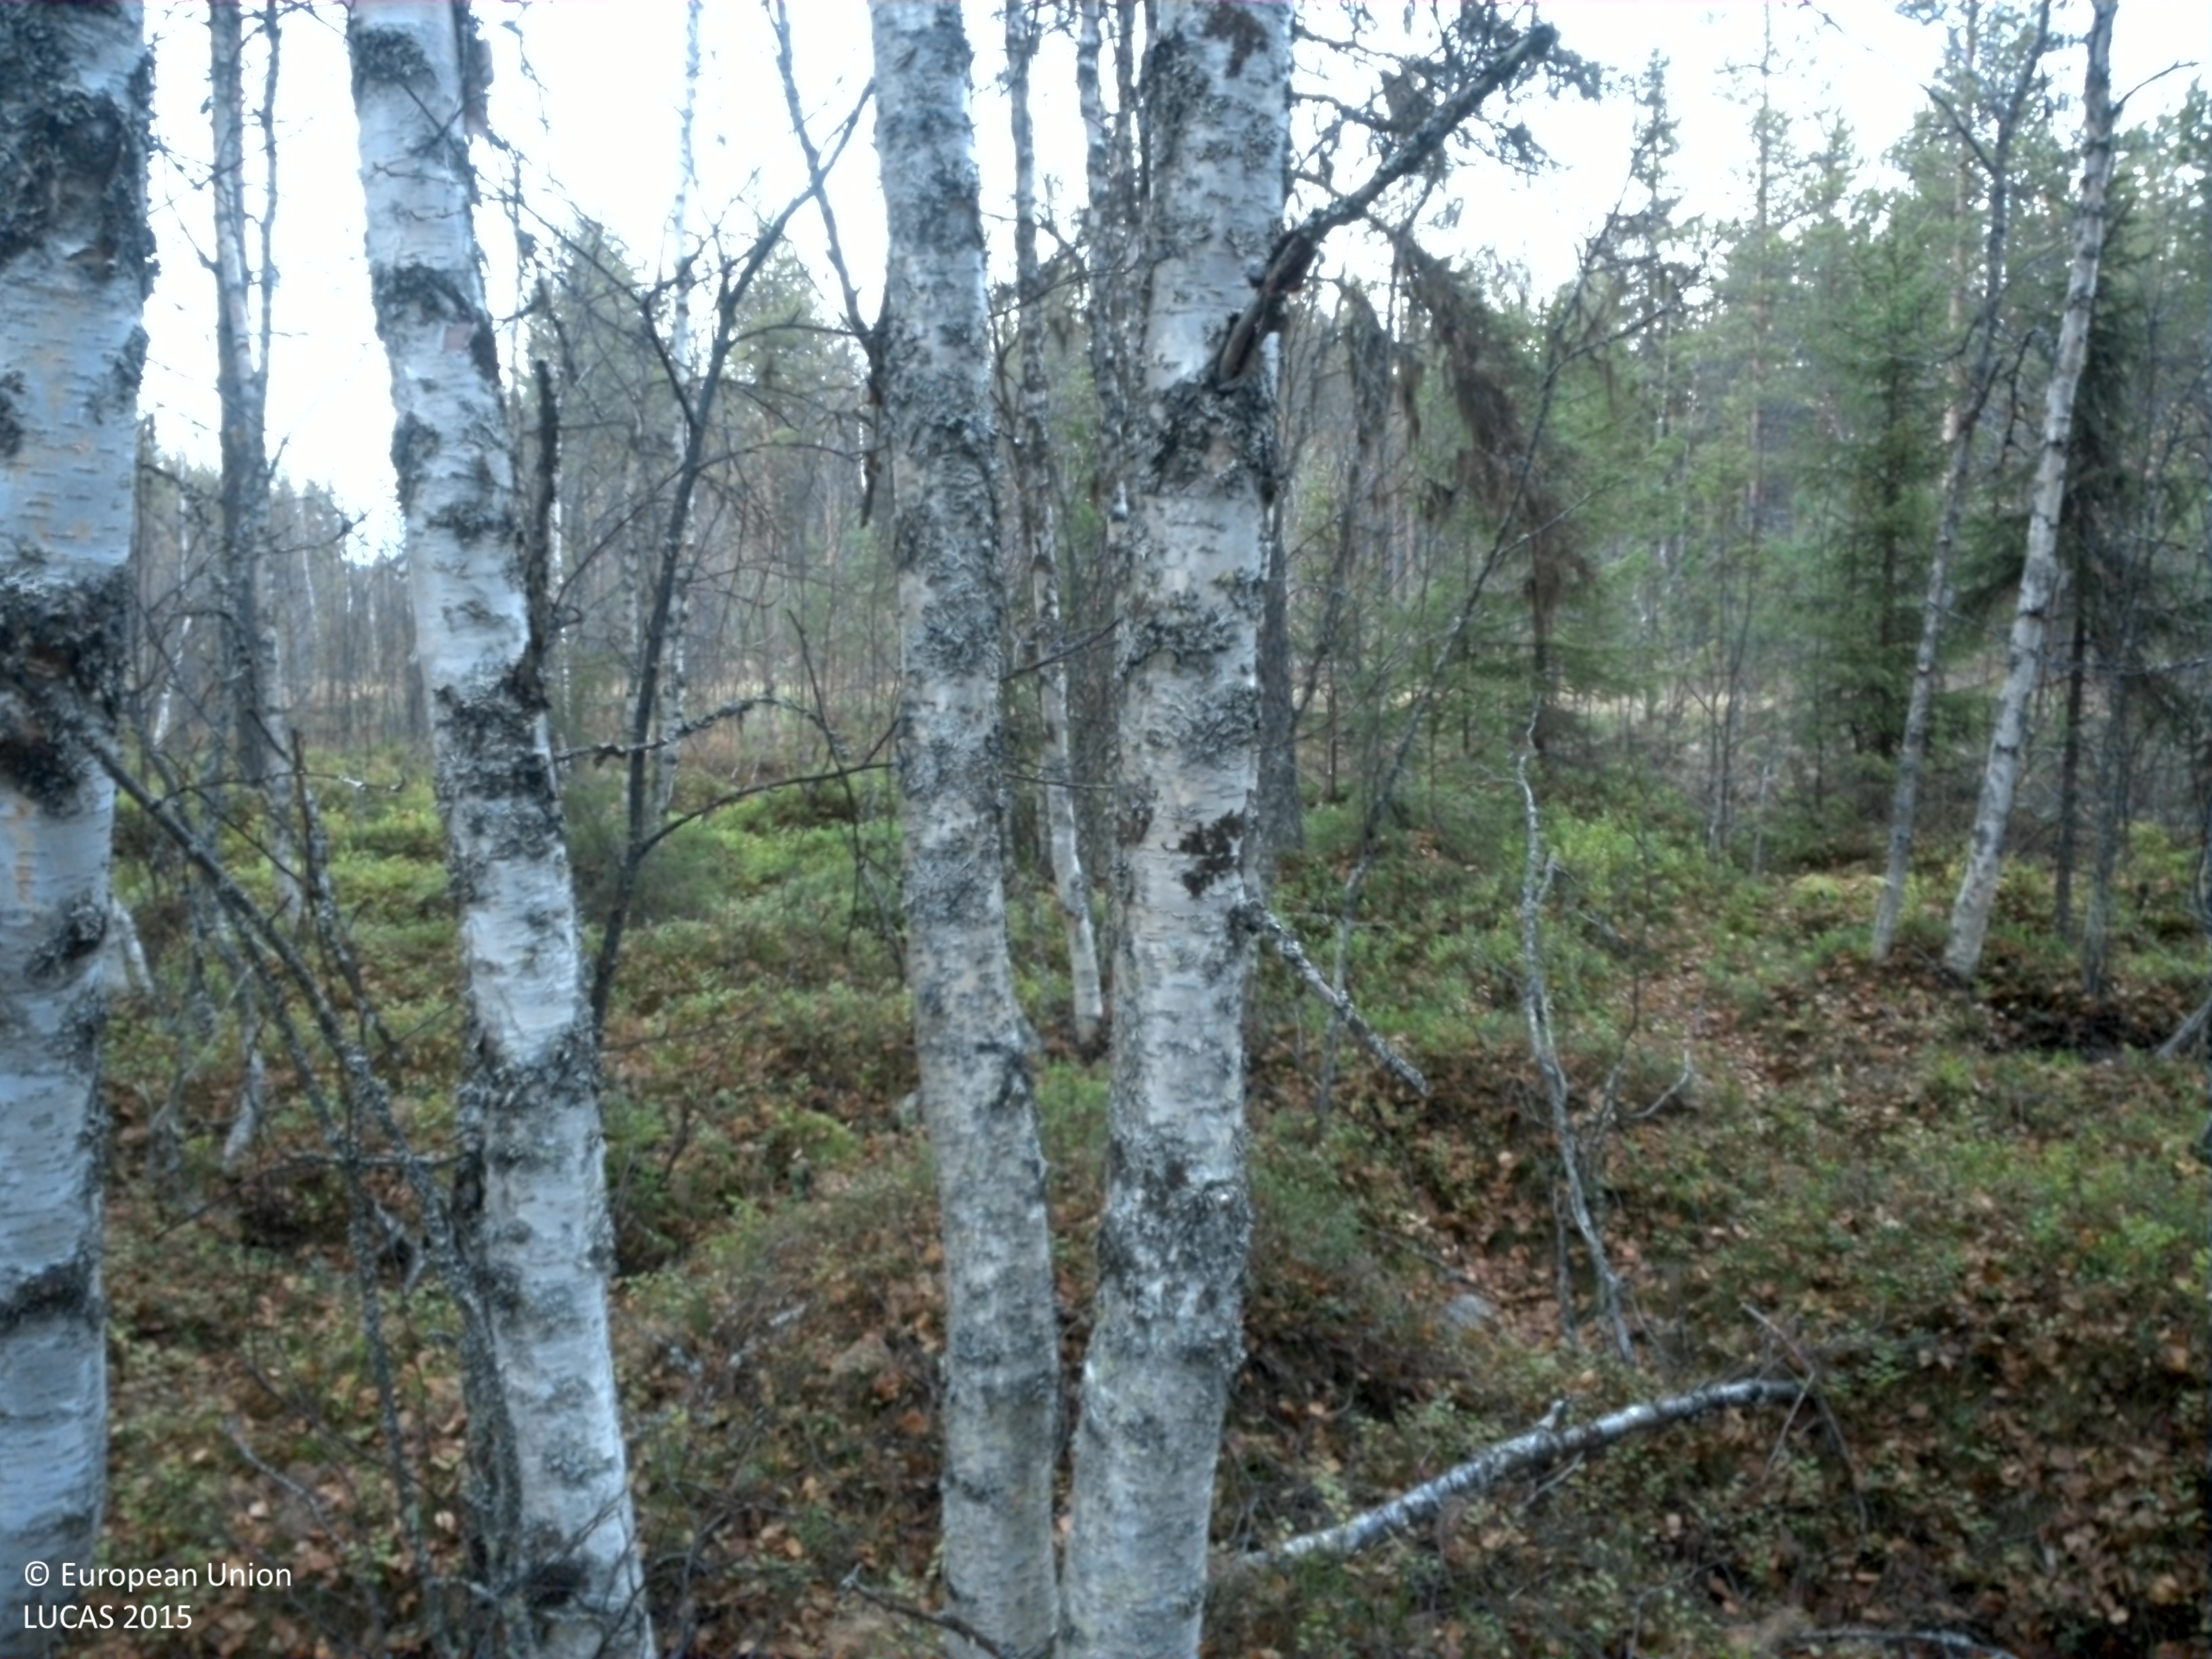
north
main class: Woodland
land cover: Other mixed woodland
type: boreal forest
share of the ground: 50 - 75 %
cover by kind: broadleaved forest trees 35 %, coniferous forest trees 25 %, shrubs 25 %, lichens and mosses 10 %, herbaceous plants 5 %
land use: Forestry
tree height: > 5 m
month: October
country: SE
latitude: 64.5927
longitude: 16.4639
